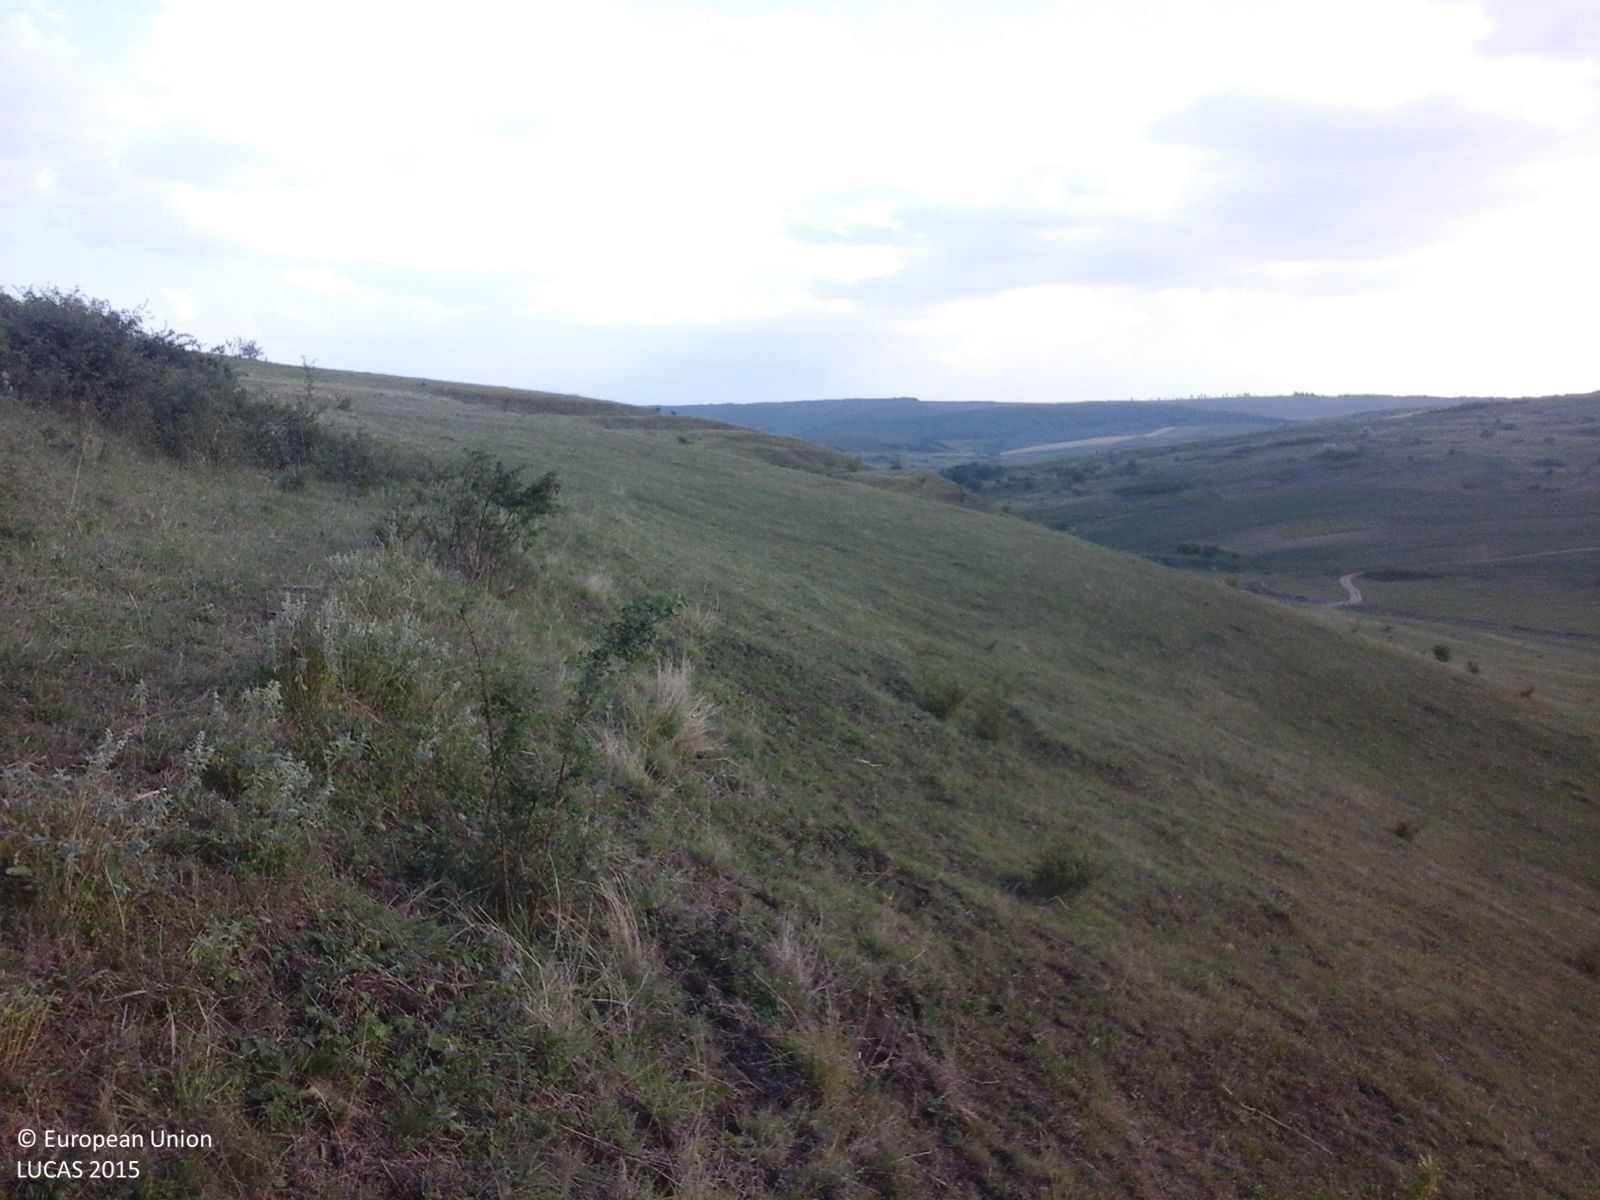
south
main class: Grassland
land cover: Grassland with sparse tree/shrub cover
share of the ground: > 75 %
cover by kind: herbaceous plants 85 %, shrubs 10 %, broadleaved forest trees 5 %
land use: Agriculture (excluding fallow land and kitchen gardens)
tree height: < 5 m
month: June
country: RO
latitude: 47.1834
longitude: 27.0055
